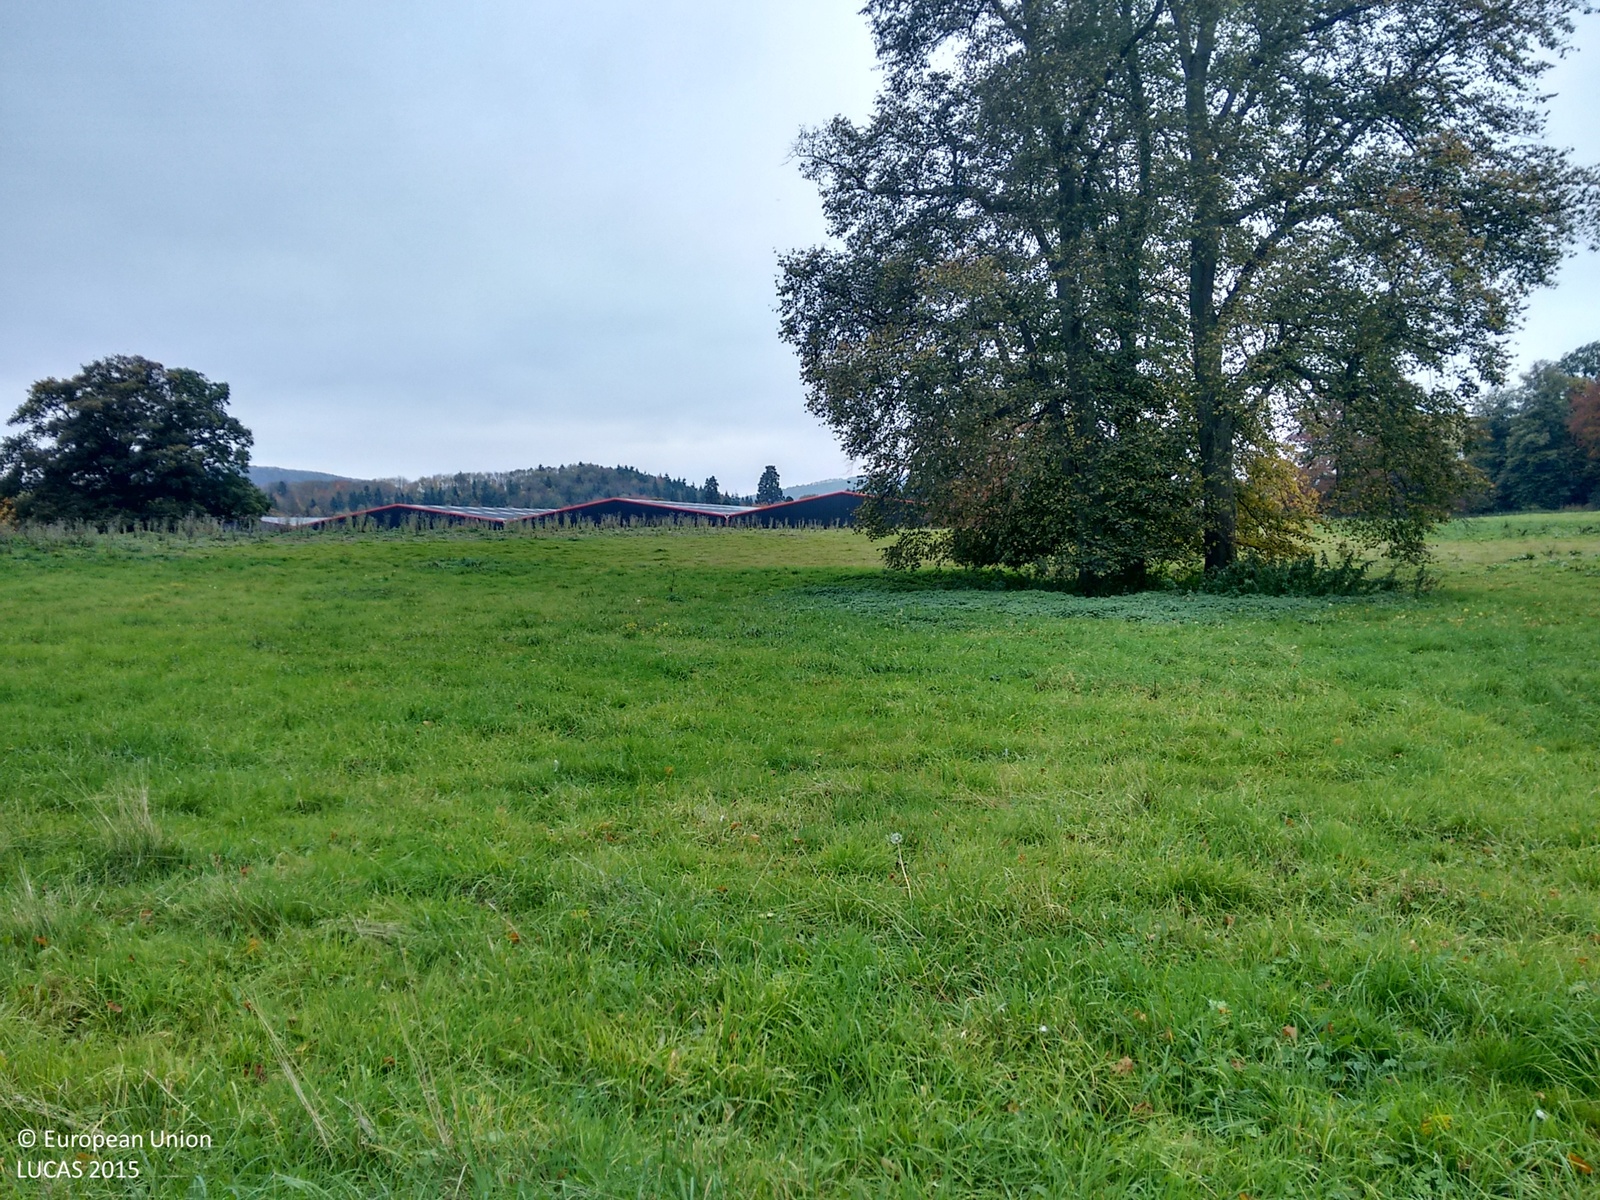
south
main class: Grassland
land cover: Grassland without tree/shrub cover
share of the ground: > 75 %
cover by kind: herbaceous plants 100 %
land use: Agriculture (excluding fallow land and kitchen gardens)
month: October
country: GB
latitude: 52.4606
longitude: -2.8322
